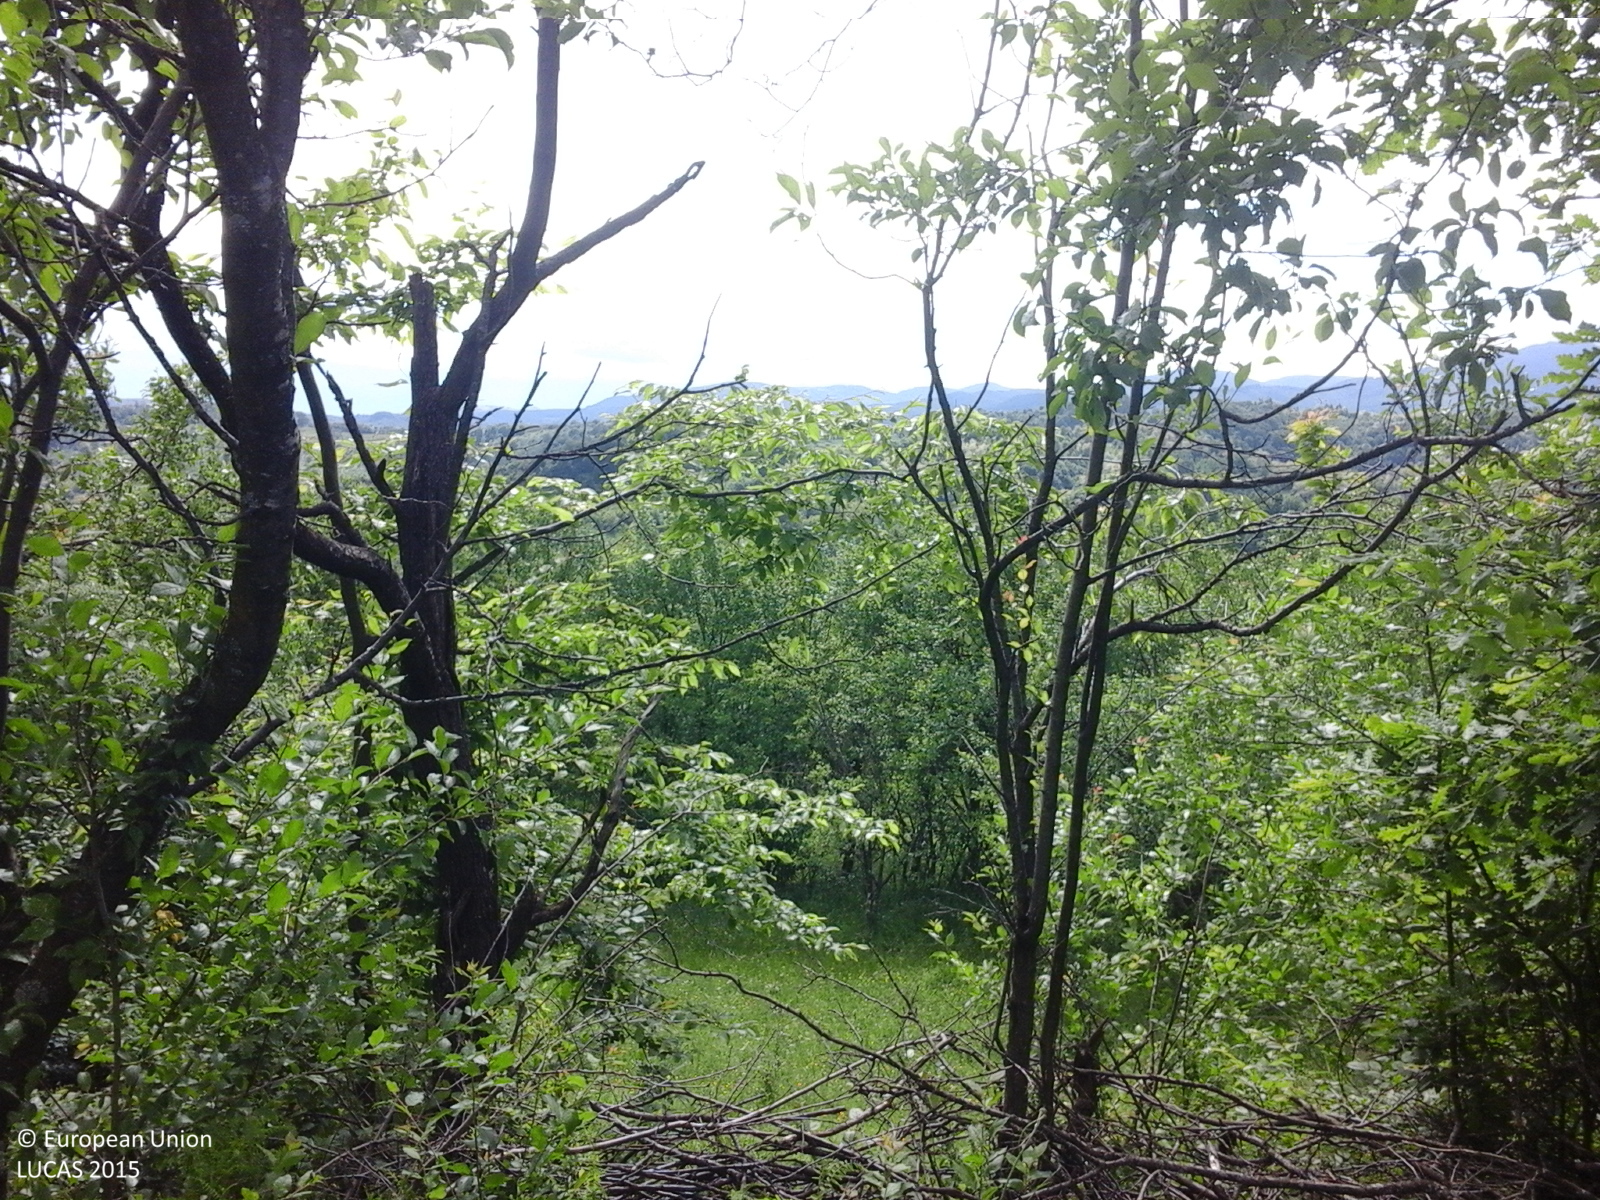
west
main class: Cropland
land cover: Other fruit trees and berries
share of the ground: 25 - 50 %
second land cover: Grassland without tree/shrub cover
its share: > 75 %
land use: Agriculture (excluding fallow land and kitchen gardens)
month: May
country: RO
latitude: 45.3136
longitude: 26.0440
